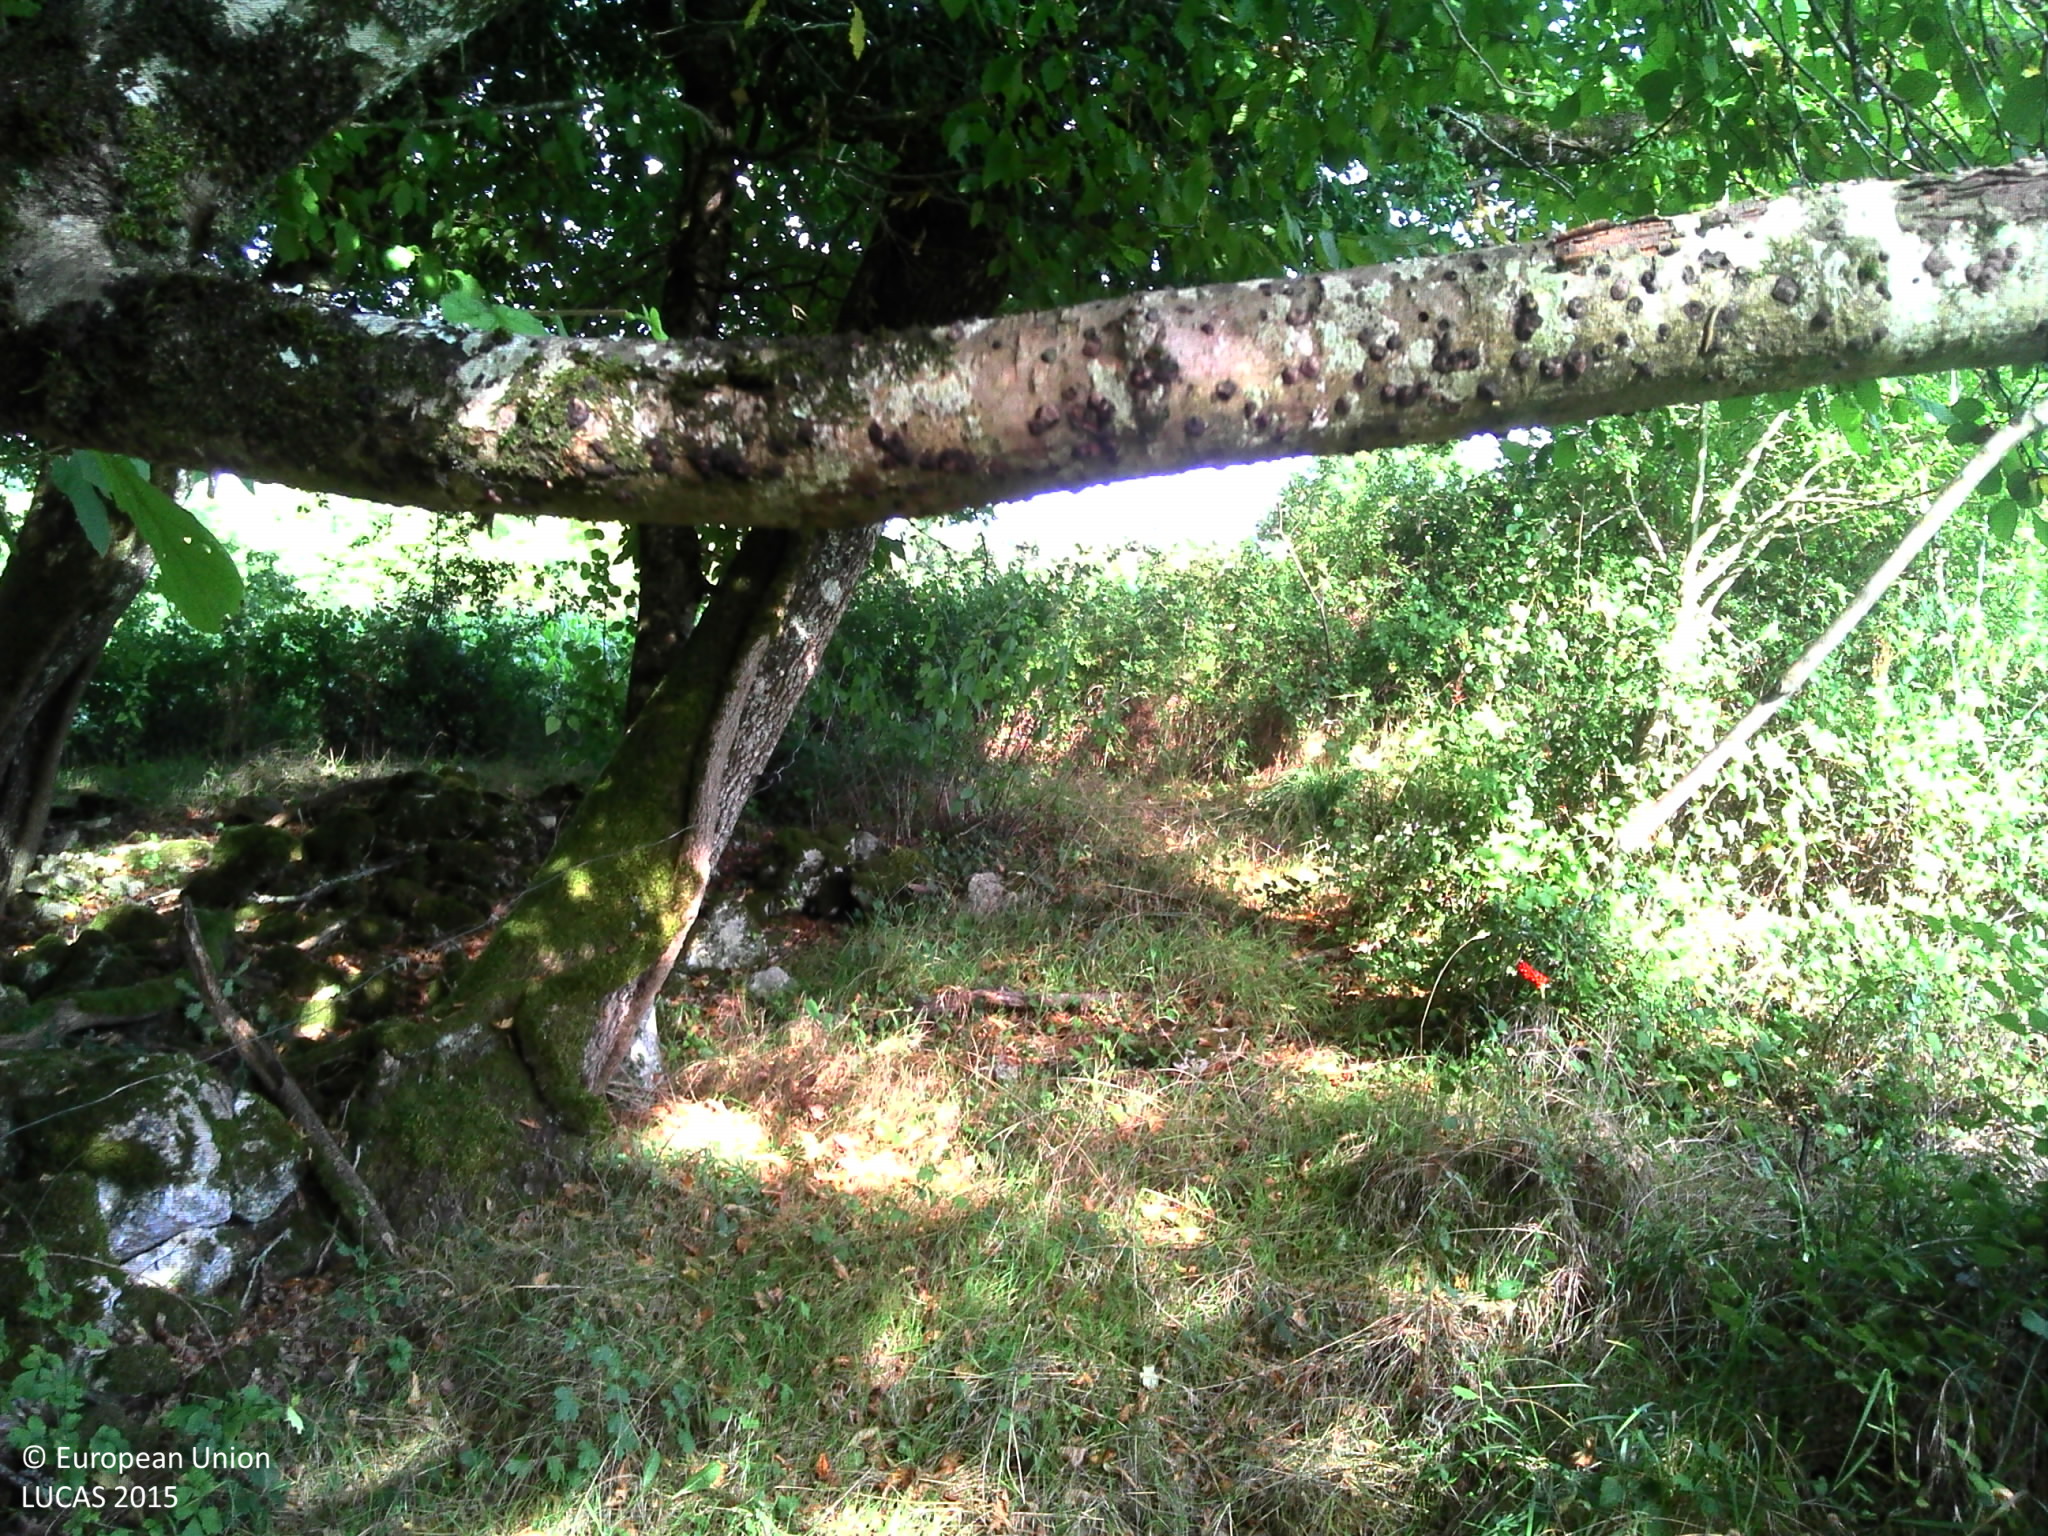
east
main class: Woodland
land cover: Broadleaved woodland
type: mesophytic deciduous forest
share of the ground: > 75 %
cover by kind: broadleaved forest trees 60 %, herbaceous plants 20 %, shrubs 10 %, lichens and mosses 10 %
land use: Forestry
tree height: > 5 m
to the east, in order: Broadleaved woodland; Fences; Maize; Fences; Grassland without tree/shrub cover; Fences; Groves; Spontaneously vegetated surfaces; Lines of trees; Durum wheat
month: August
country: FR
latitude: 45.4191
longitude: 0.4923
